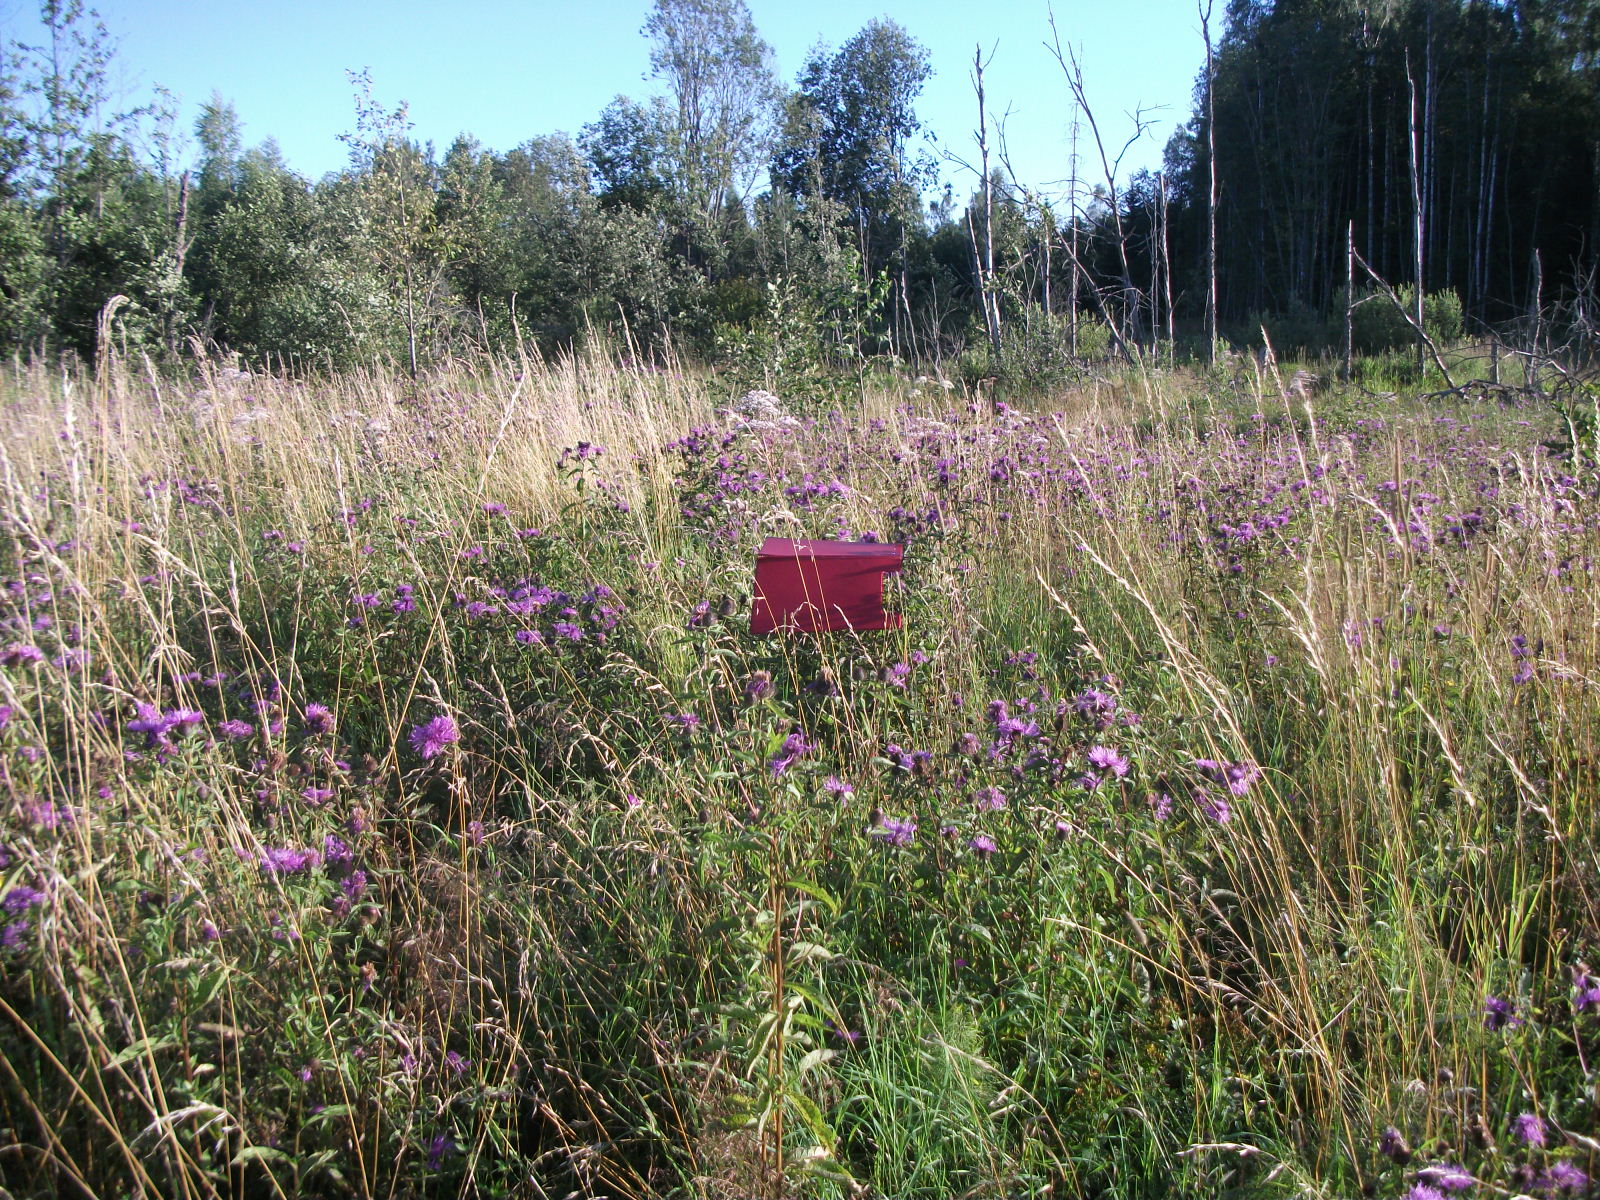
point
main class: Grassland
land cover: Grassland with sparse tree/shrub cover
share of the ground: > 75 %
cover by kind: herbaceous plants 90 %, broadleaved forest trees 5 %, shrubs 5 %
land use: Semi-natural and natural areas not in use
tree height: < 5 m
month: August
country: LV
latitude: 57.0614
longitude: 26.4861
